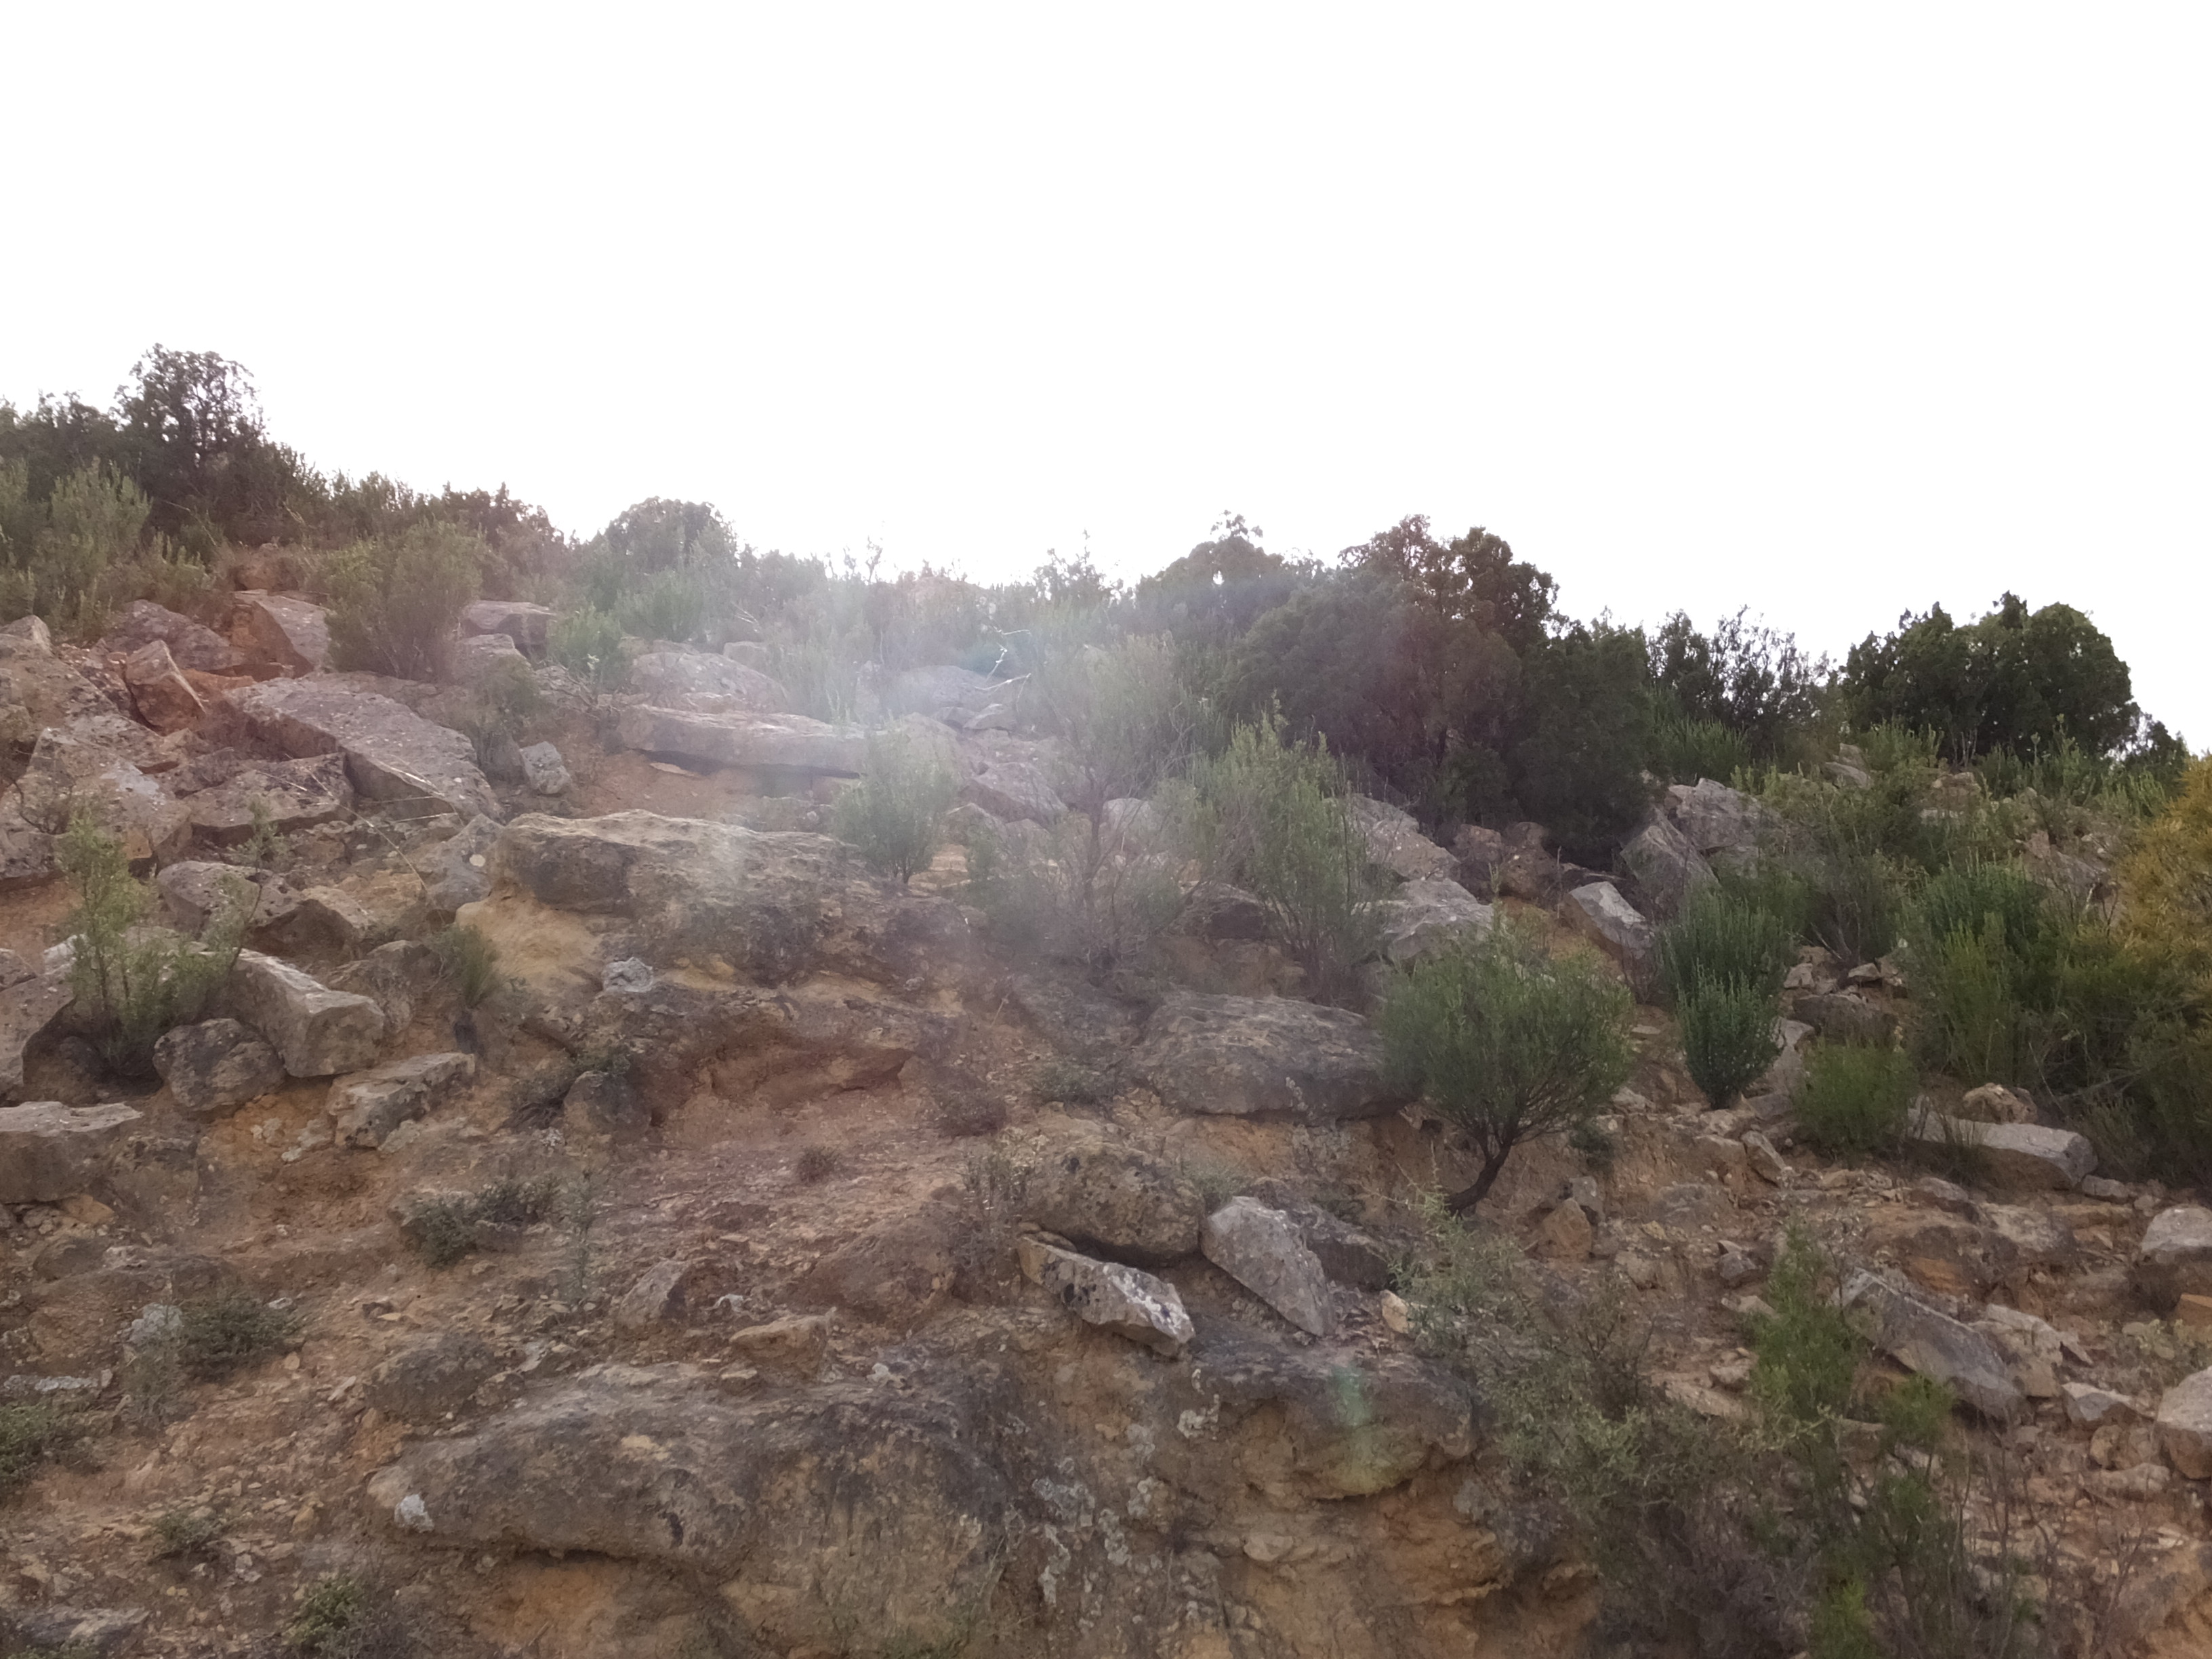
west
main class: Shrubland
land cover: Shrubland with sparse tree cover
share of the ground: > 75 %
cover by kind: shrubs 75 %, herbaceous plants 20 %, coniferous forest trees 5 %
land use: Semi-natural and natural areas not in use
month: May
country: ES
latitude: 41.3136
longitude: -0.2515
